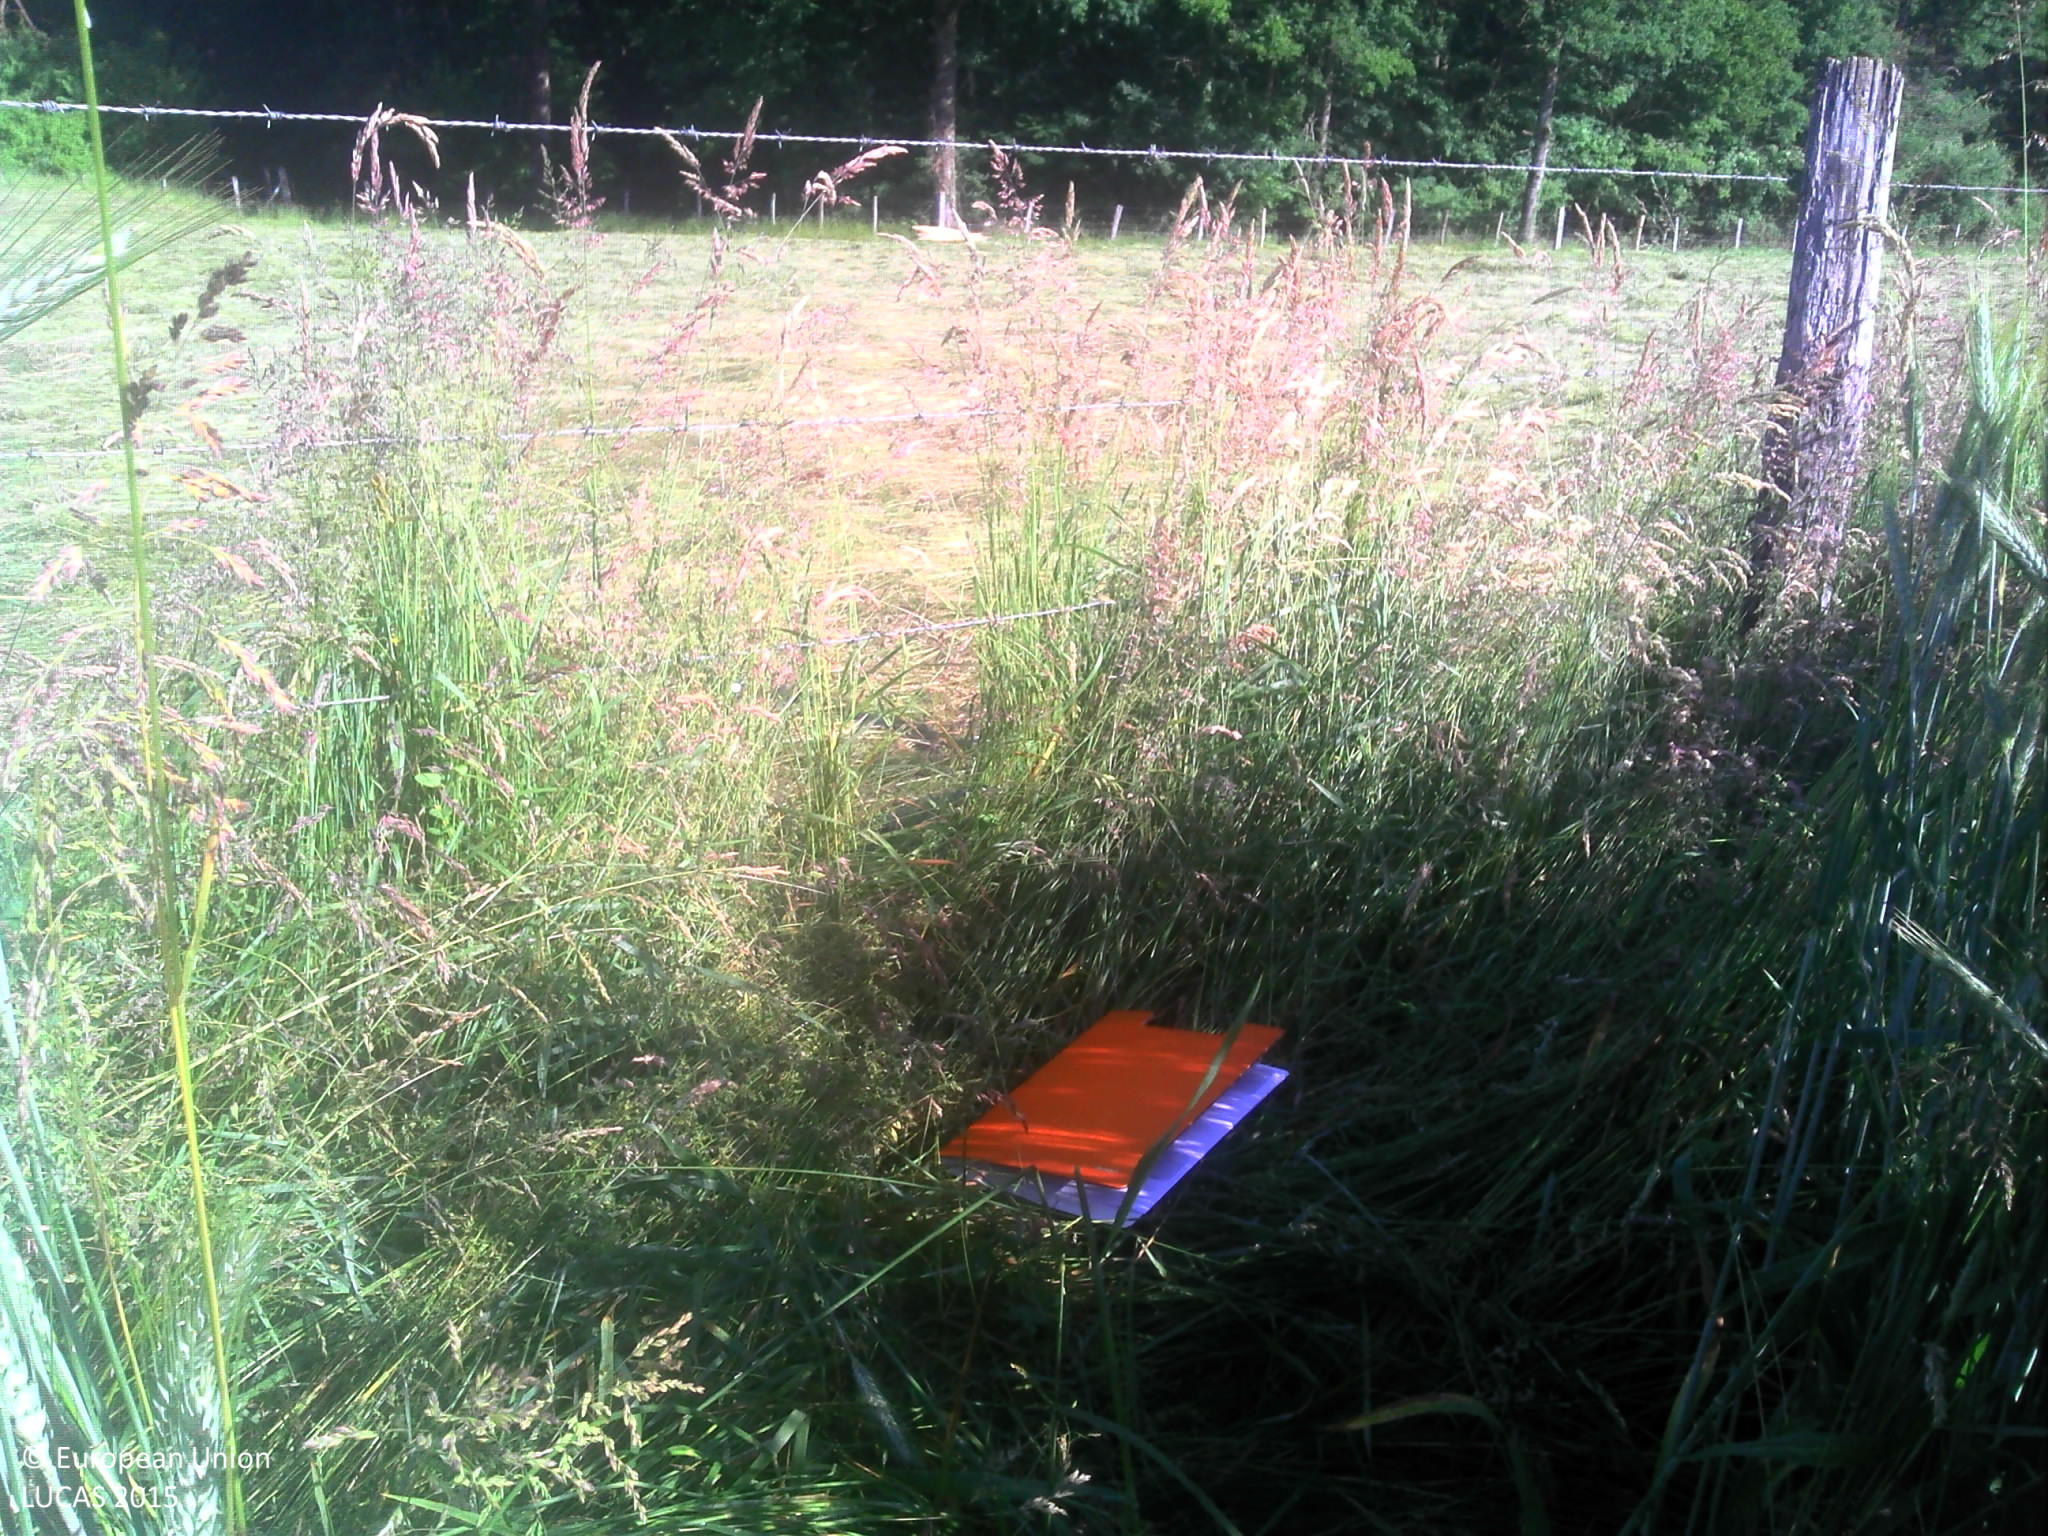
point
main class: Cropland
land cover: Triticale
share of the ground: > 75 %
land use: Agriculture (excluding fallow land and kitchen gardens)
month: June
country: FR
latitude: 48.5098
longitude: 4.6779
